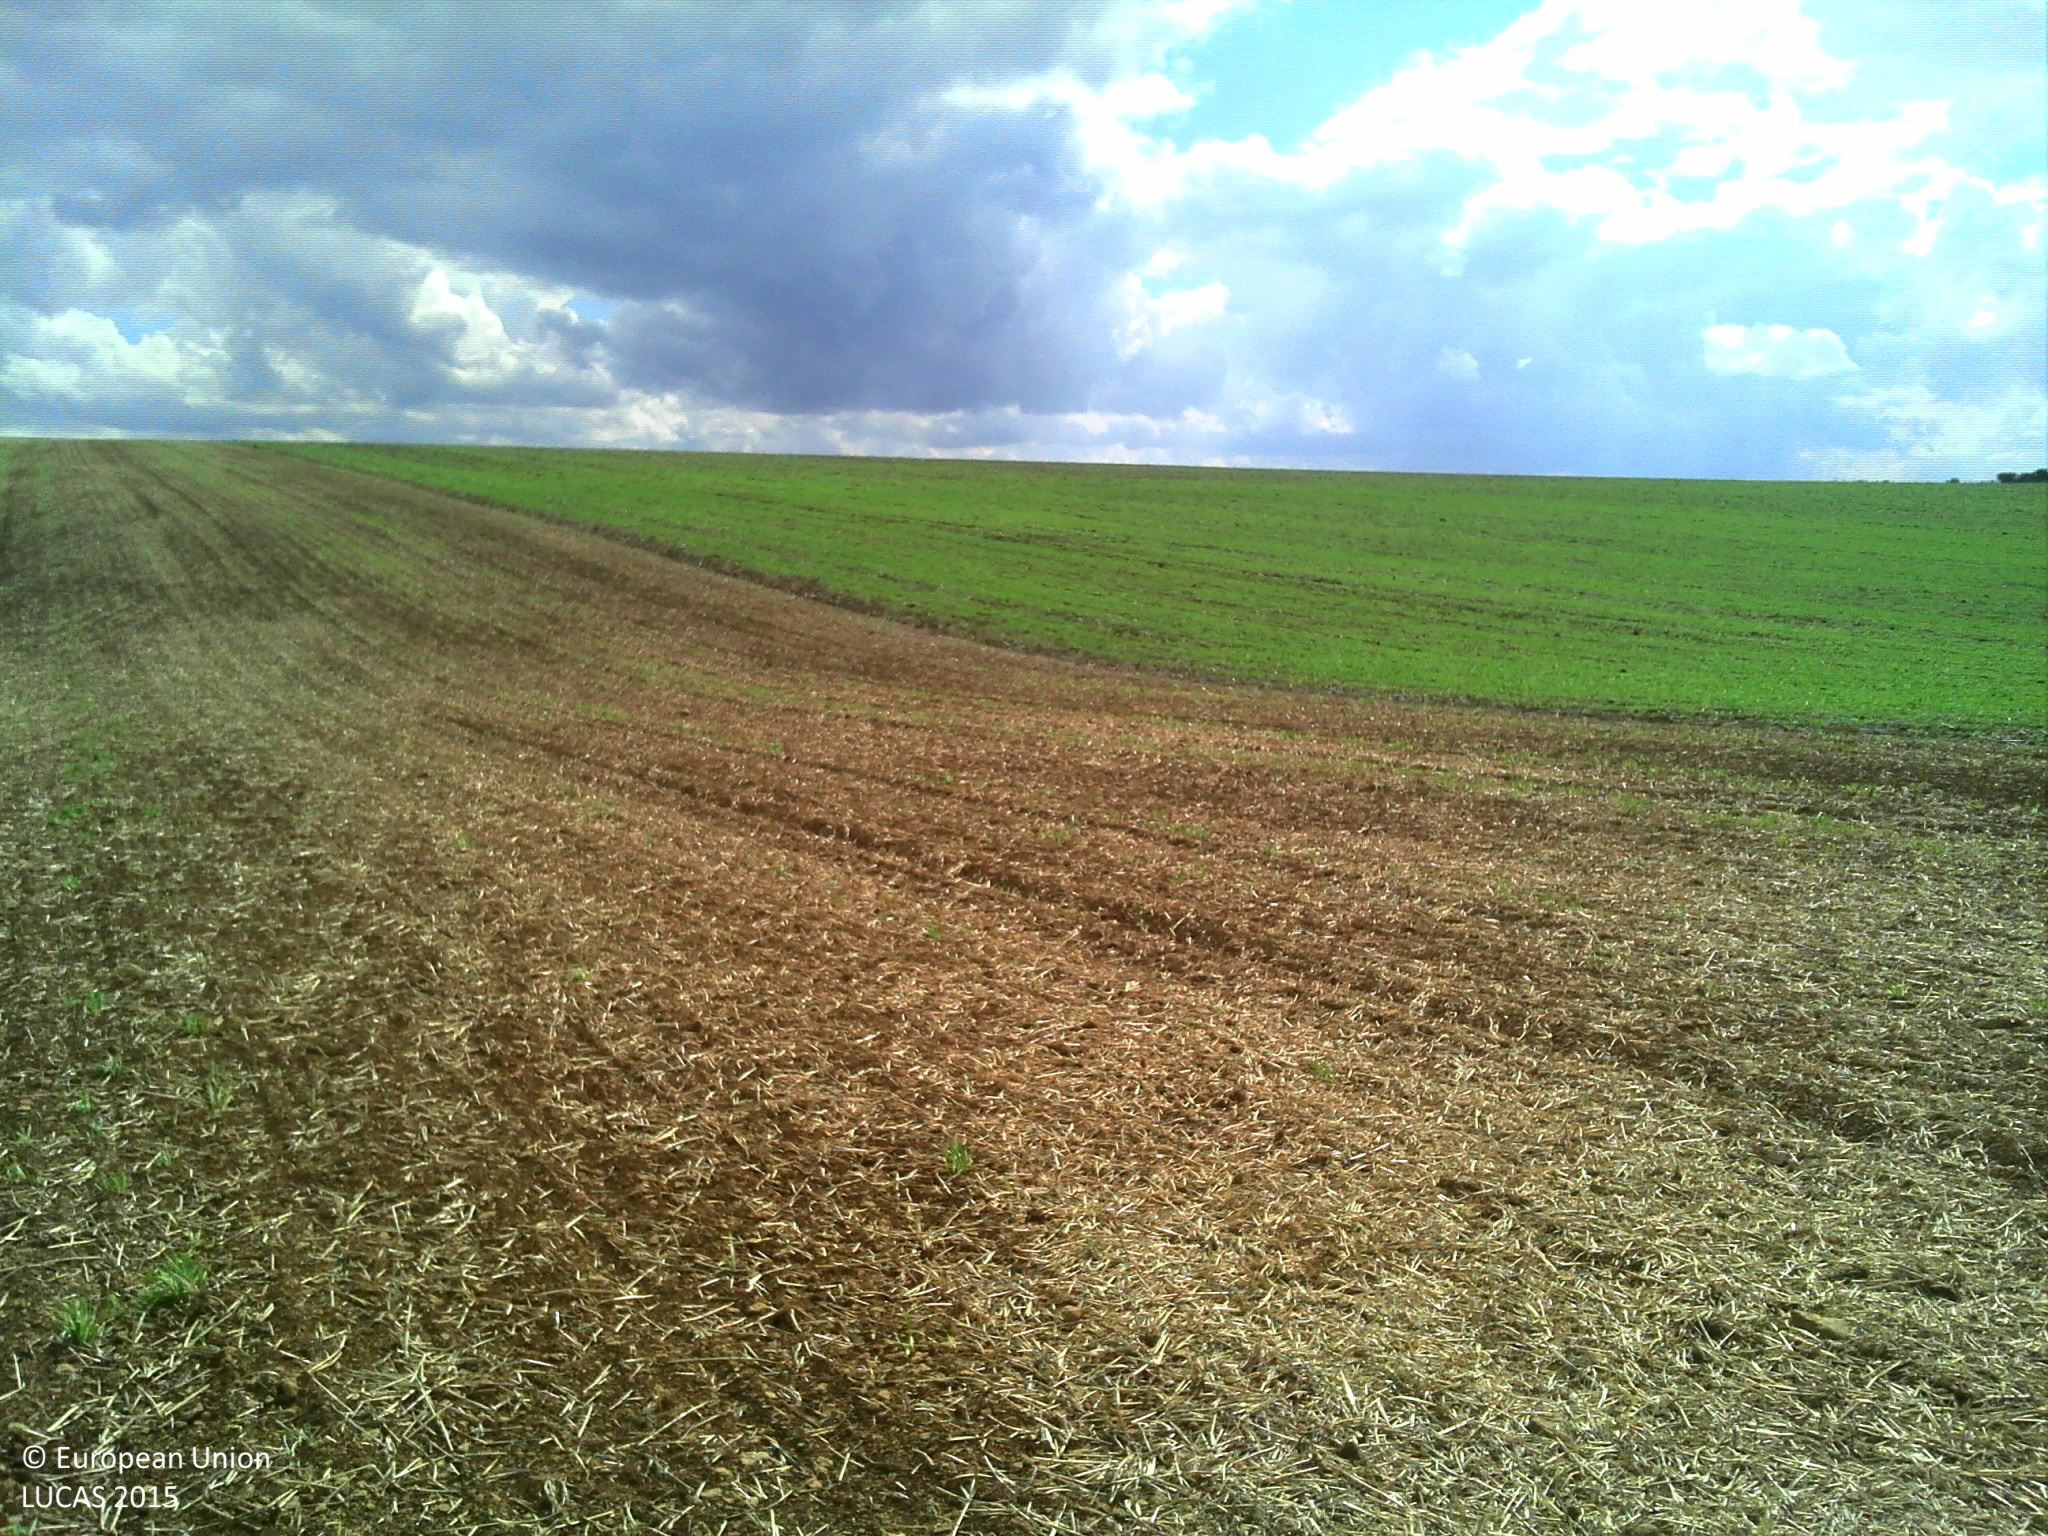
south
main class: Cropland
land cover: Common wheat
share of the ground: < 10 %
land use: Agriculture (excluding fallow land and kitchen gardens)
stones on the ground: 10 - 25 %
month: September
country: FR
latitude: 49.1392
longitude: 5.9284
